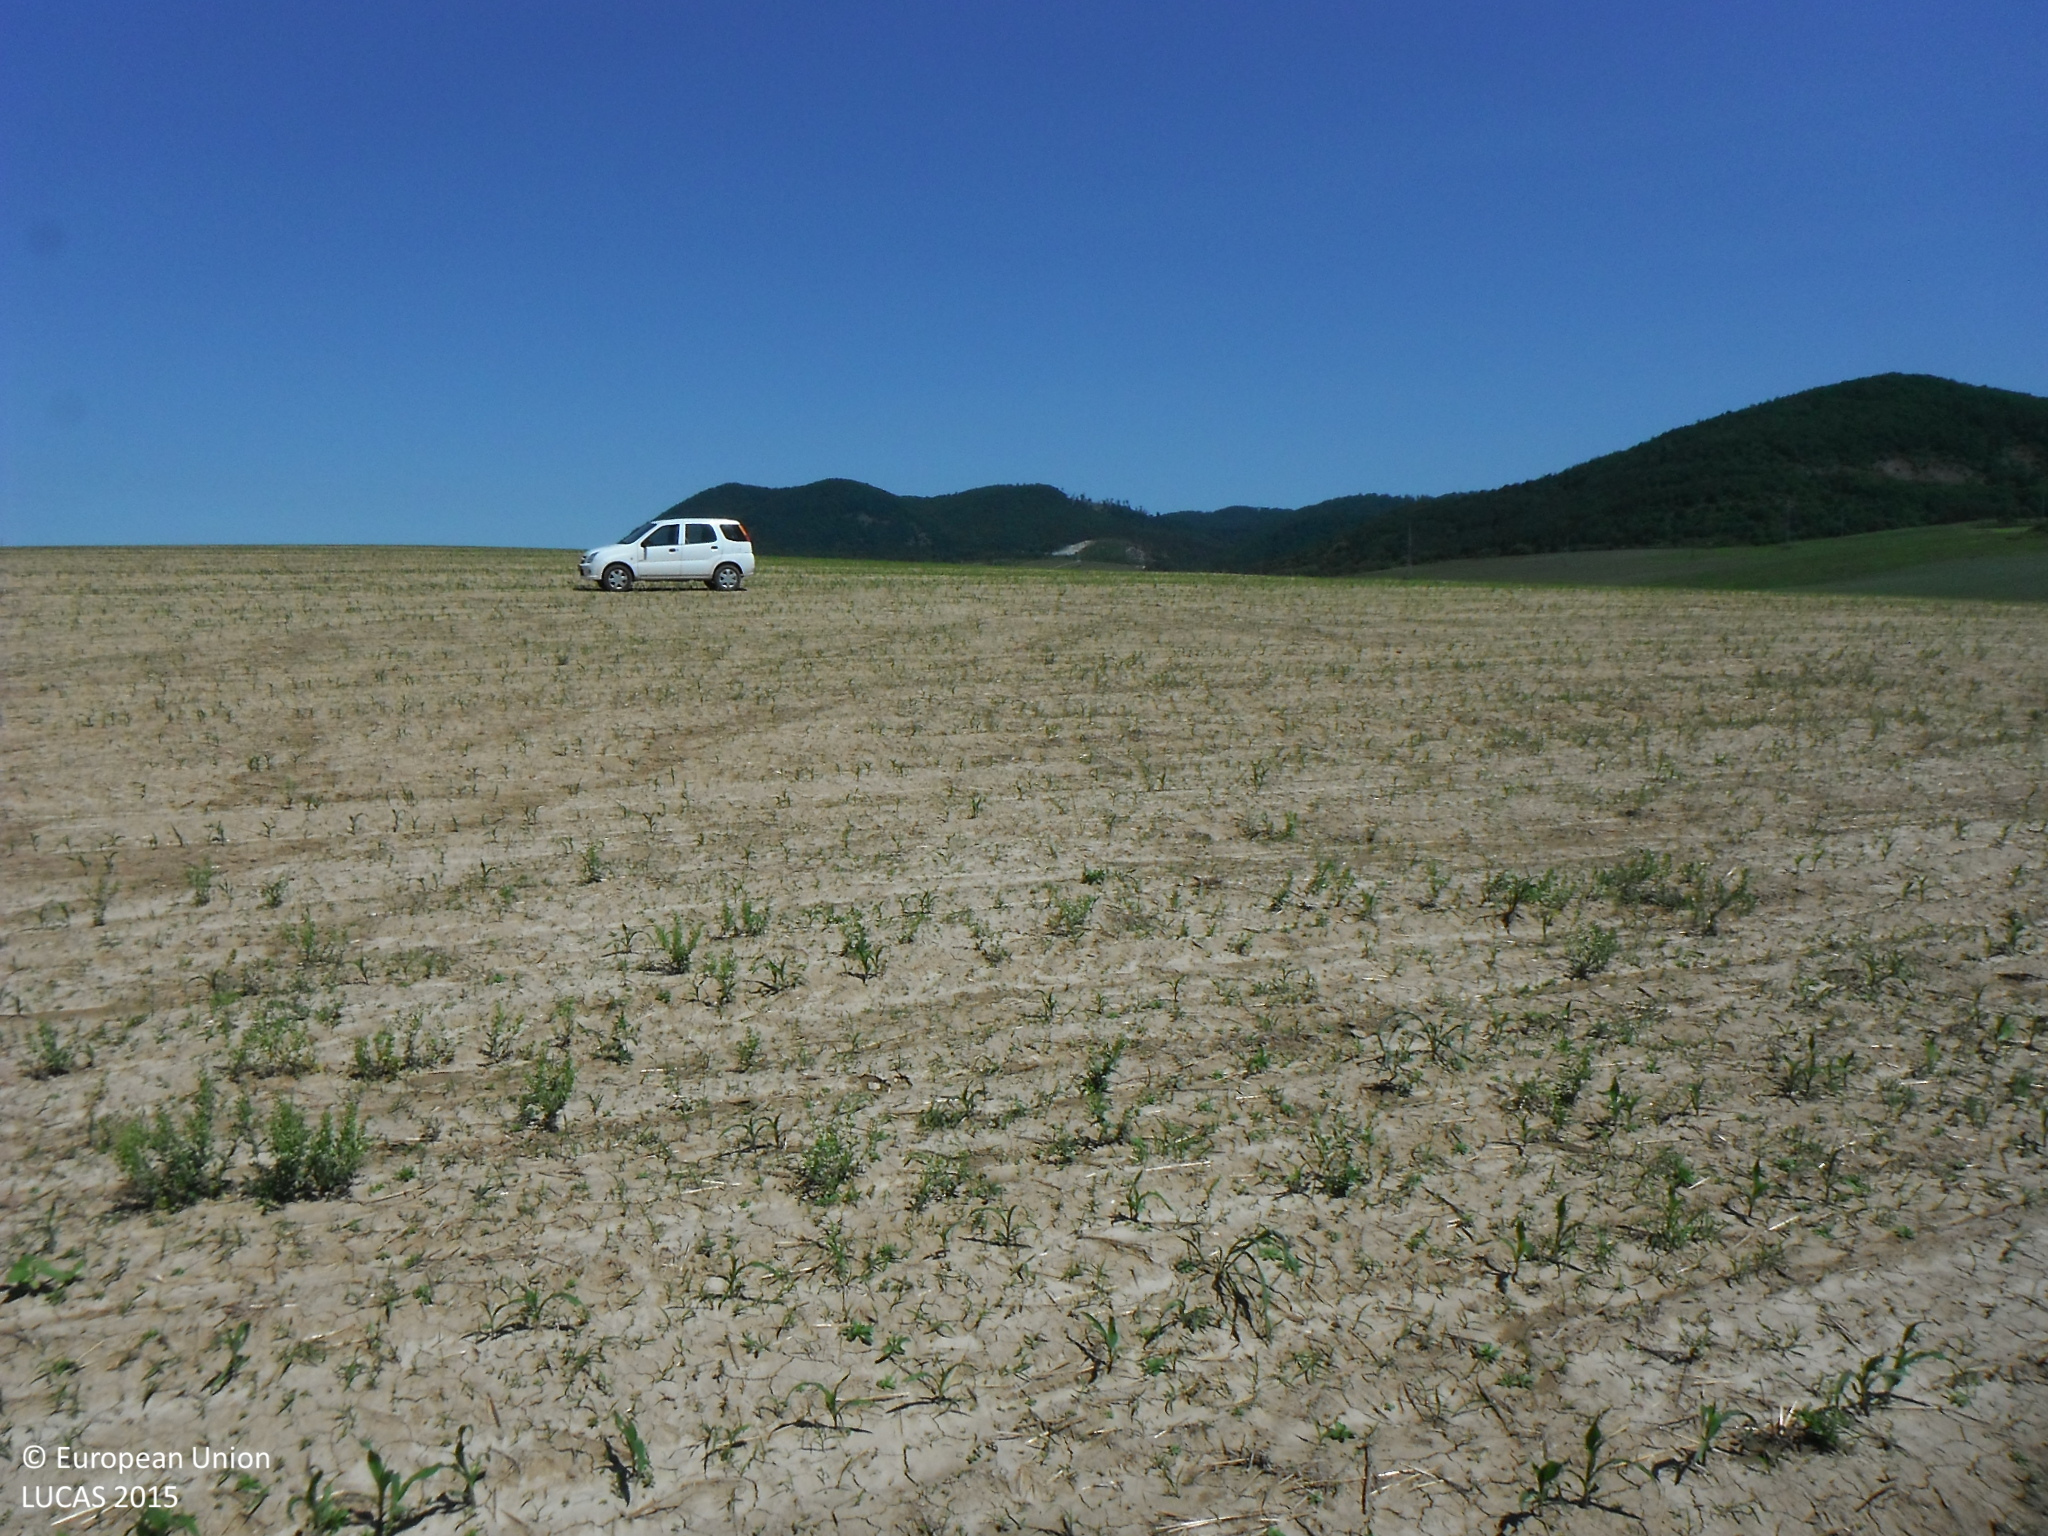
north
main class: Cropland
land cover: Maize
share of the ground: < 10 %
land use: Agriculture (excluding fallow land and kitchen gardens)
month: June
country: SK
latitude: 48.8531
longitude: 21.3442
